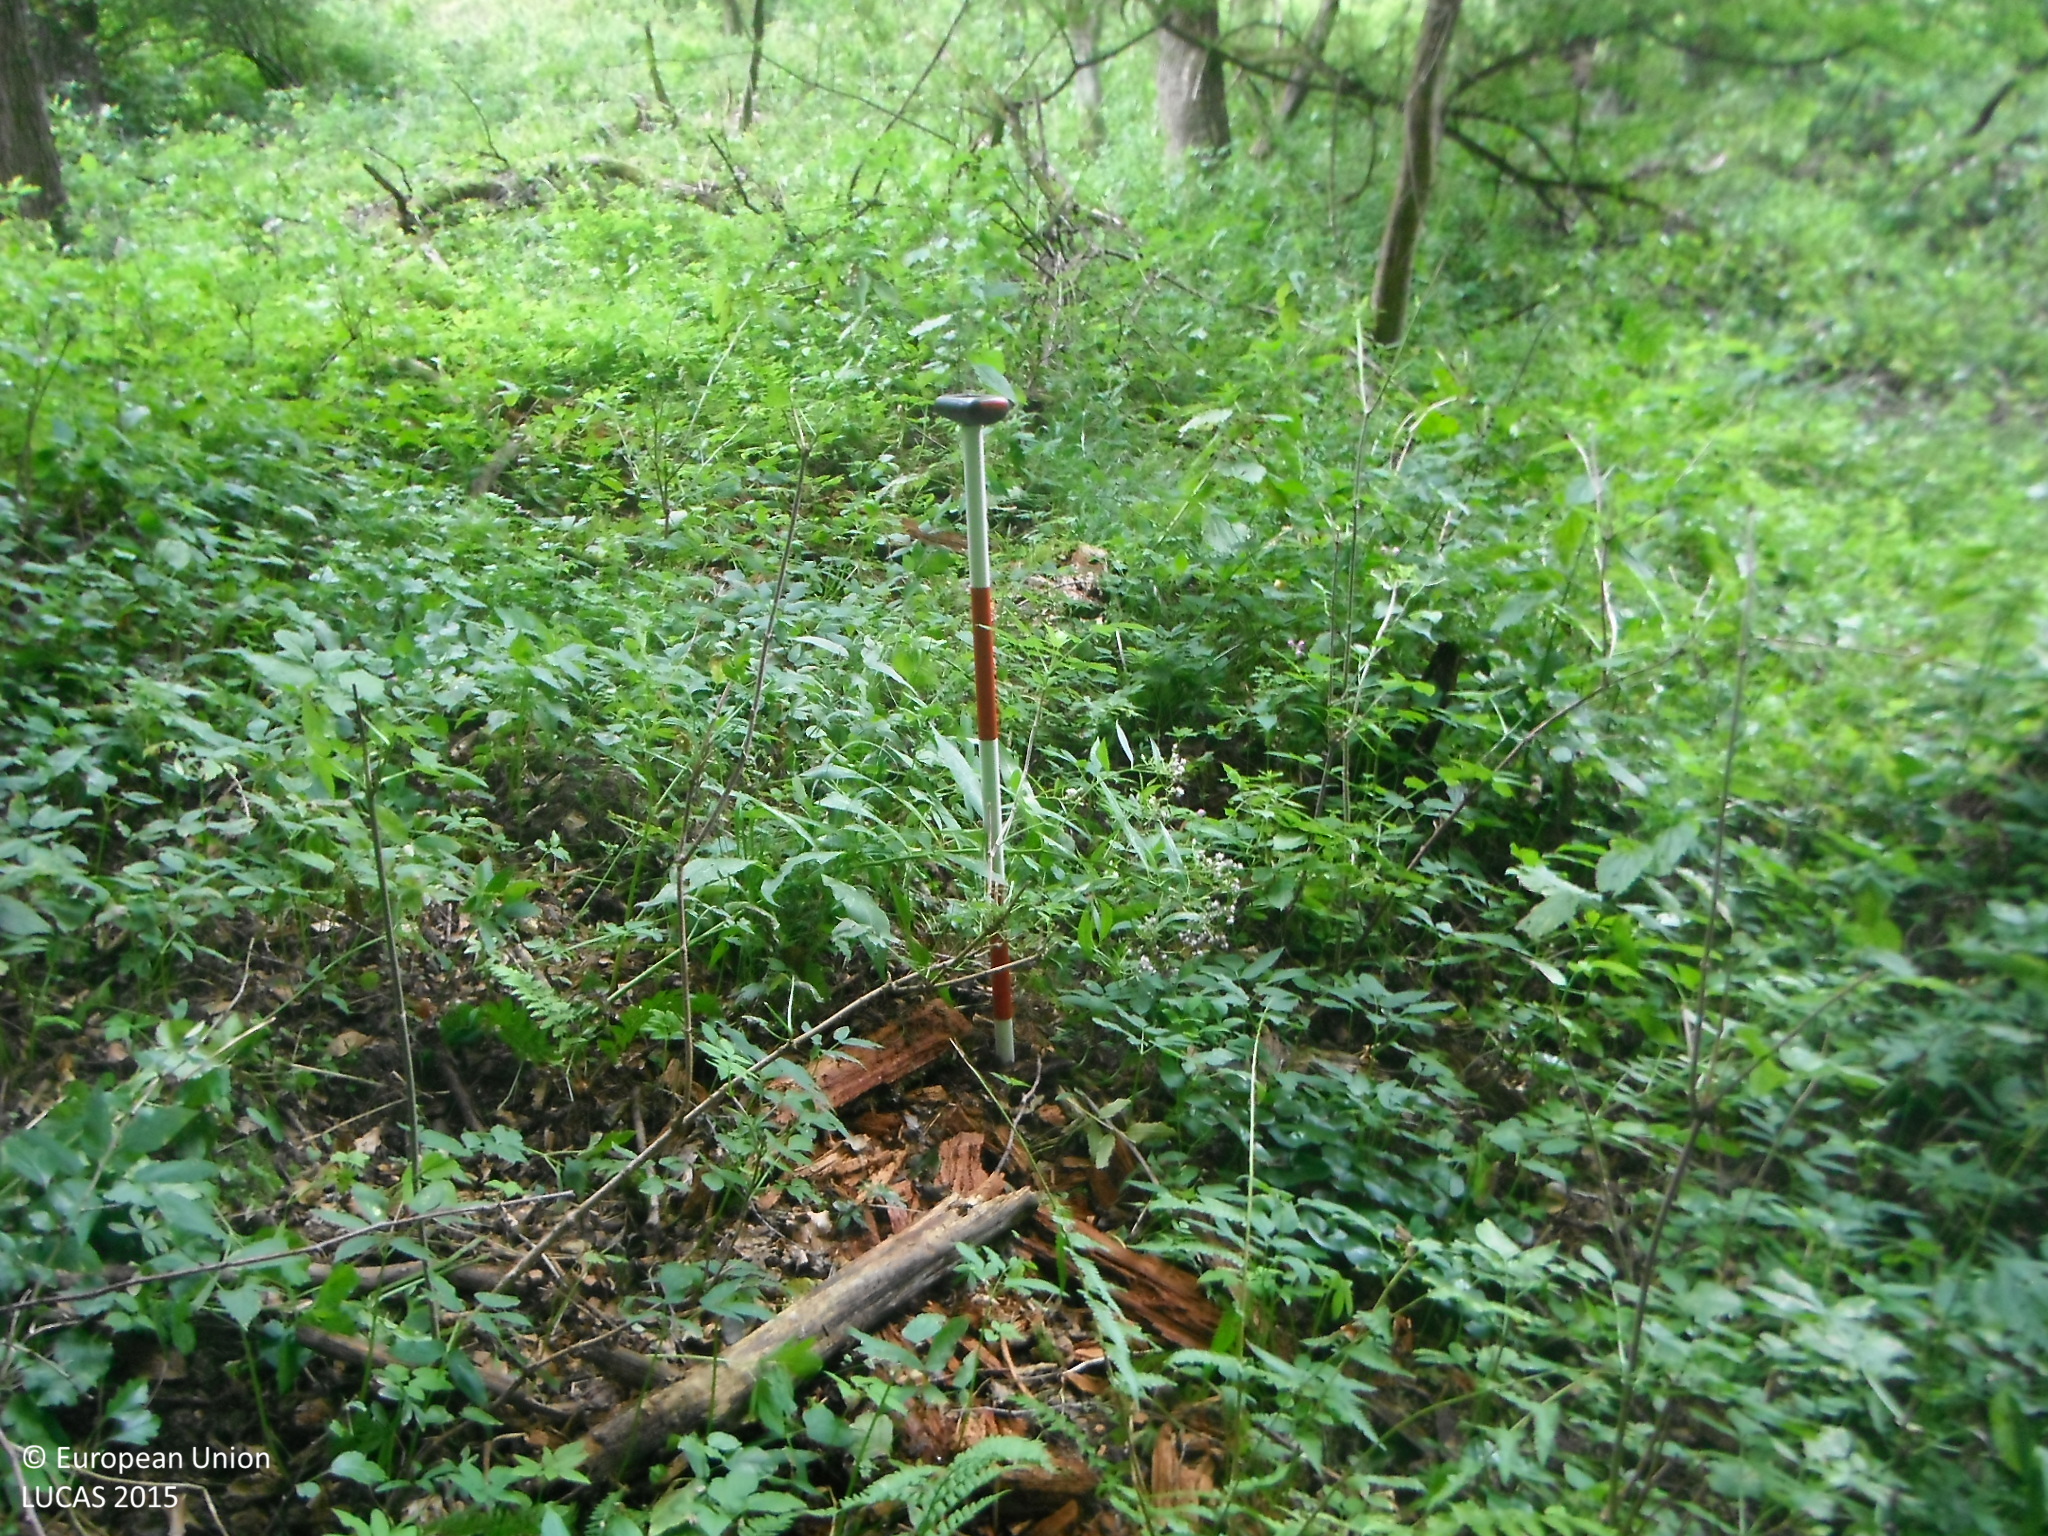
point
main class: Woodland
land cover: Broadleaved woodland
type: beech forest
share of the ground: > 75 %
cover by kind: broadleaved forest trees 85 %, shrubs 10 %, herbaceous plants 5 %
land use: Forestry
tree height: > 5 m
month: September
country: SK
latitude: 48.8774
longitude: 18.1830
